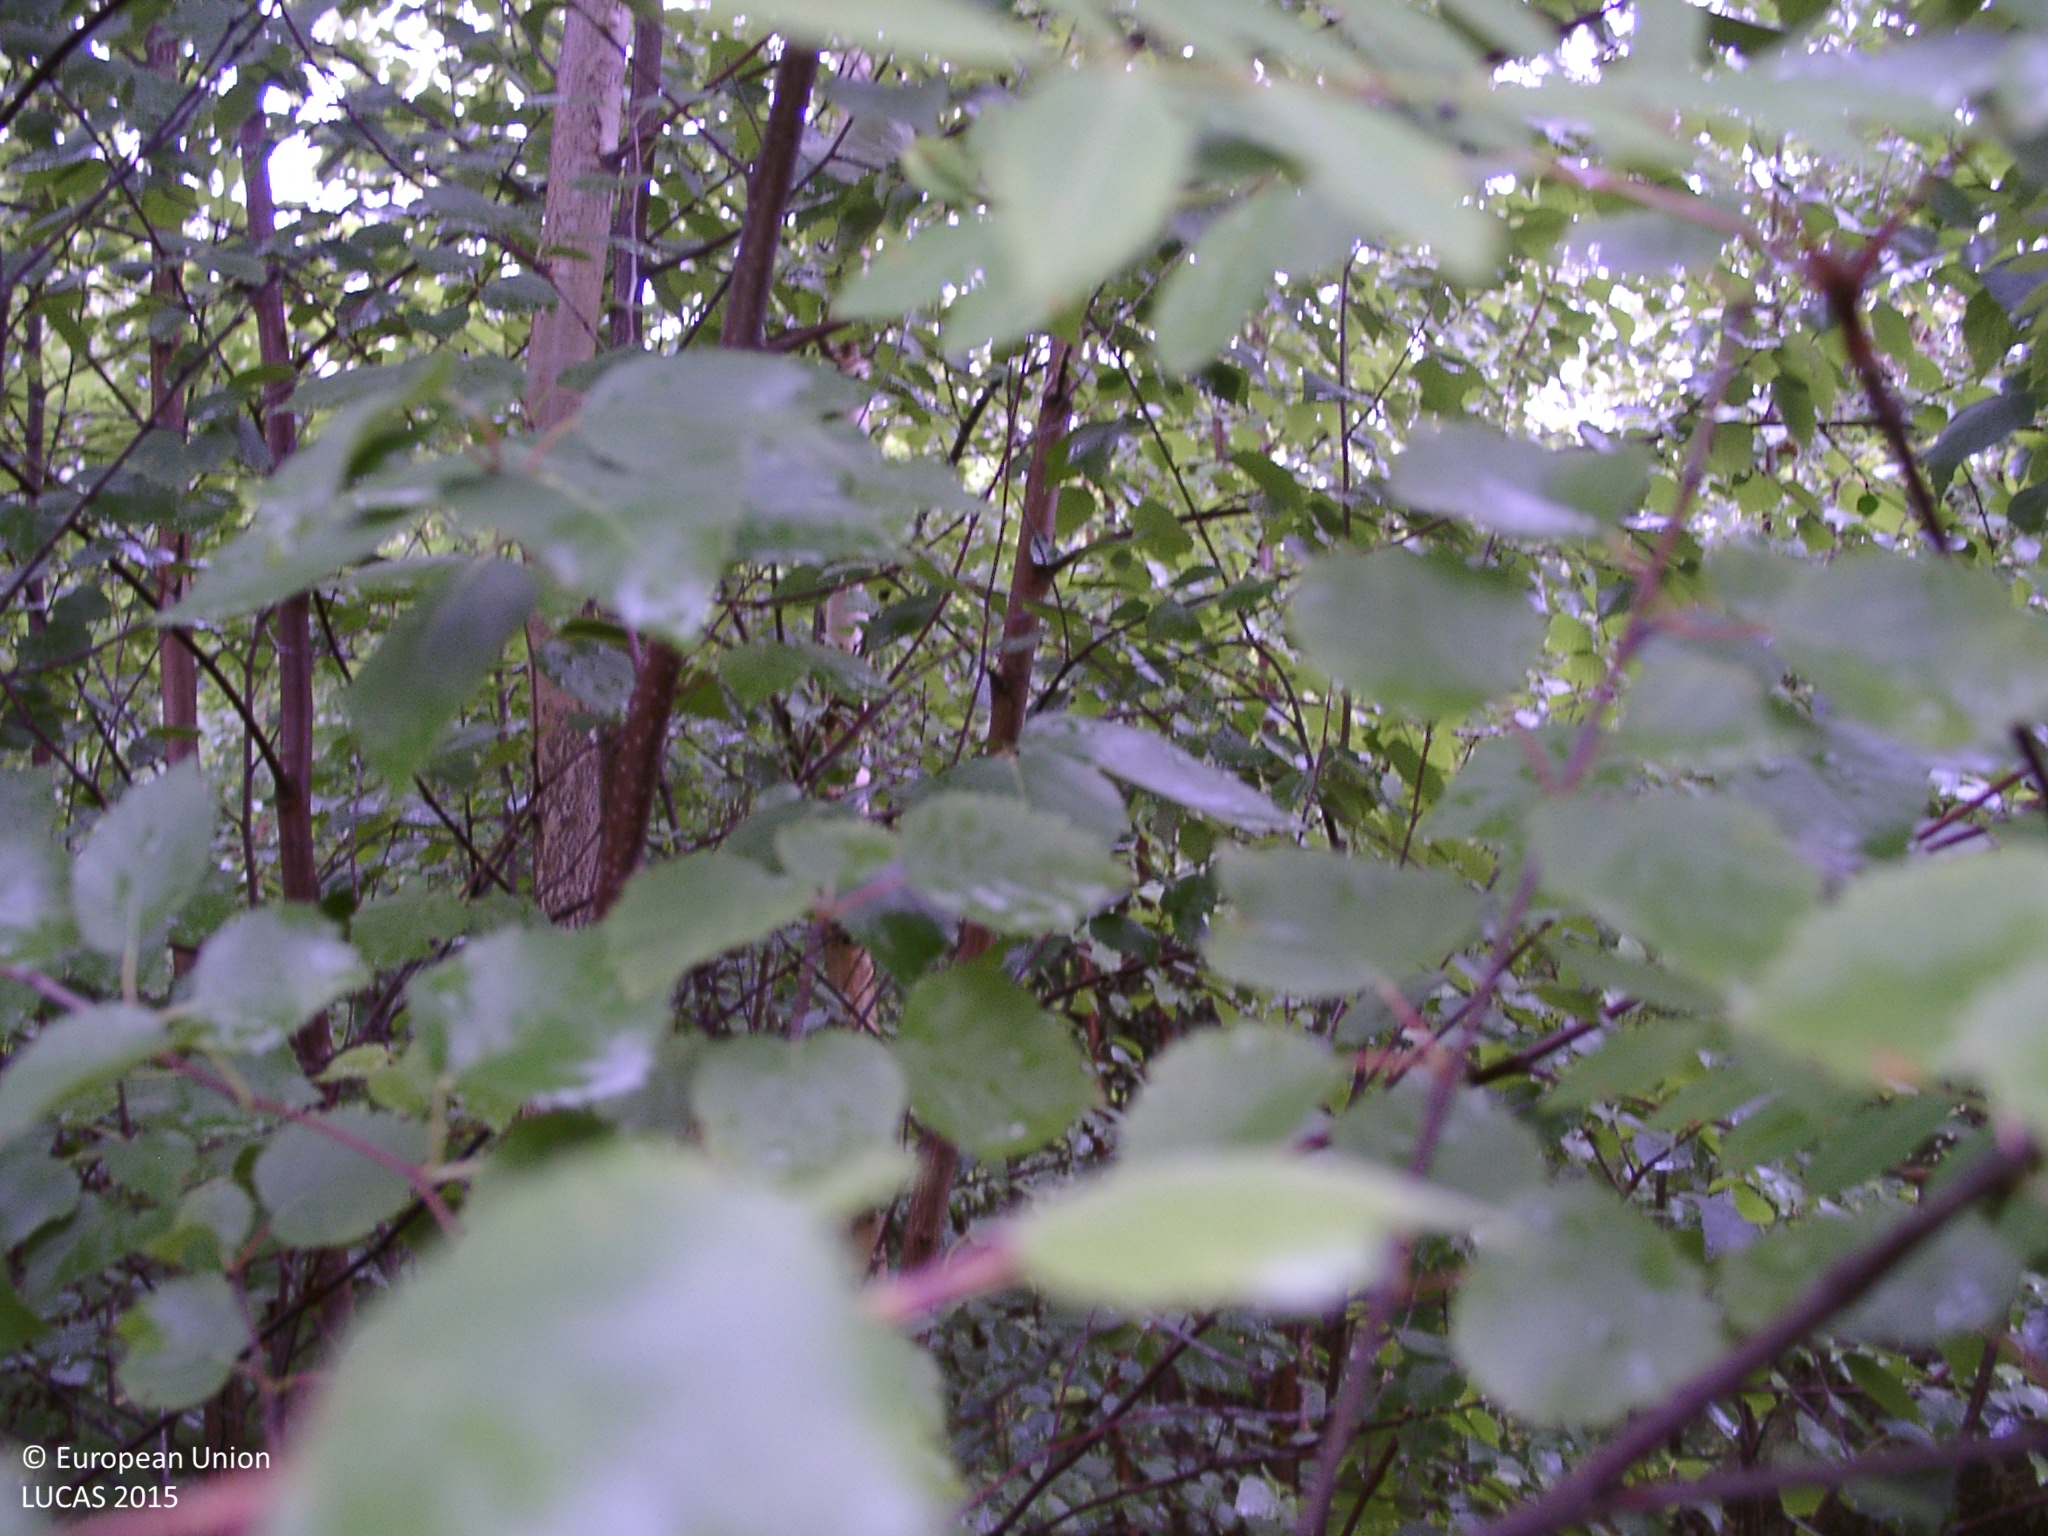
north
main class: Woodland
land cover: Spruce dominated mixed woodland
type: boreal forest
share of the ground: > 75 %
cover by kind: broadleaved forest trees 60 %, coniferous forest trees 20 %, herbaceous plants 20 %
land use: Forestry
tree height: < 5 m
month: July
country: FI
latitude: 62.2360
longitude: 25.4102
